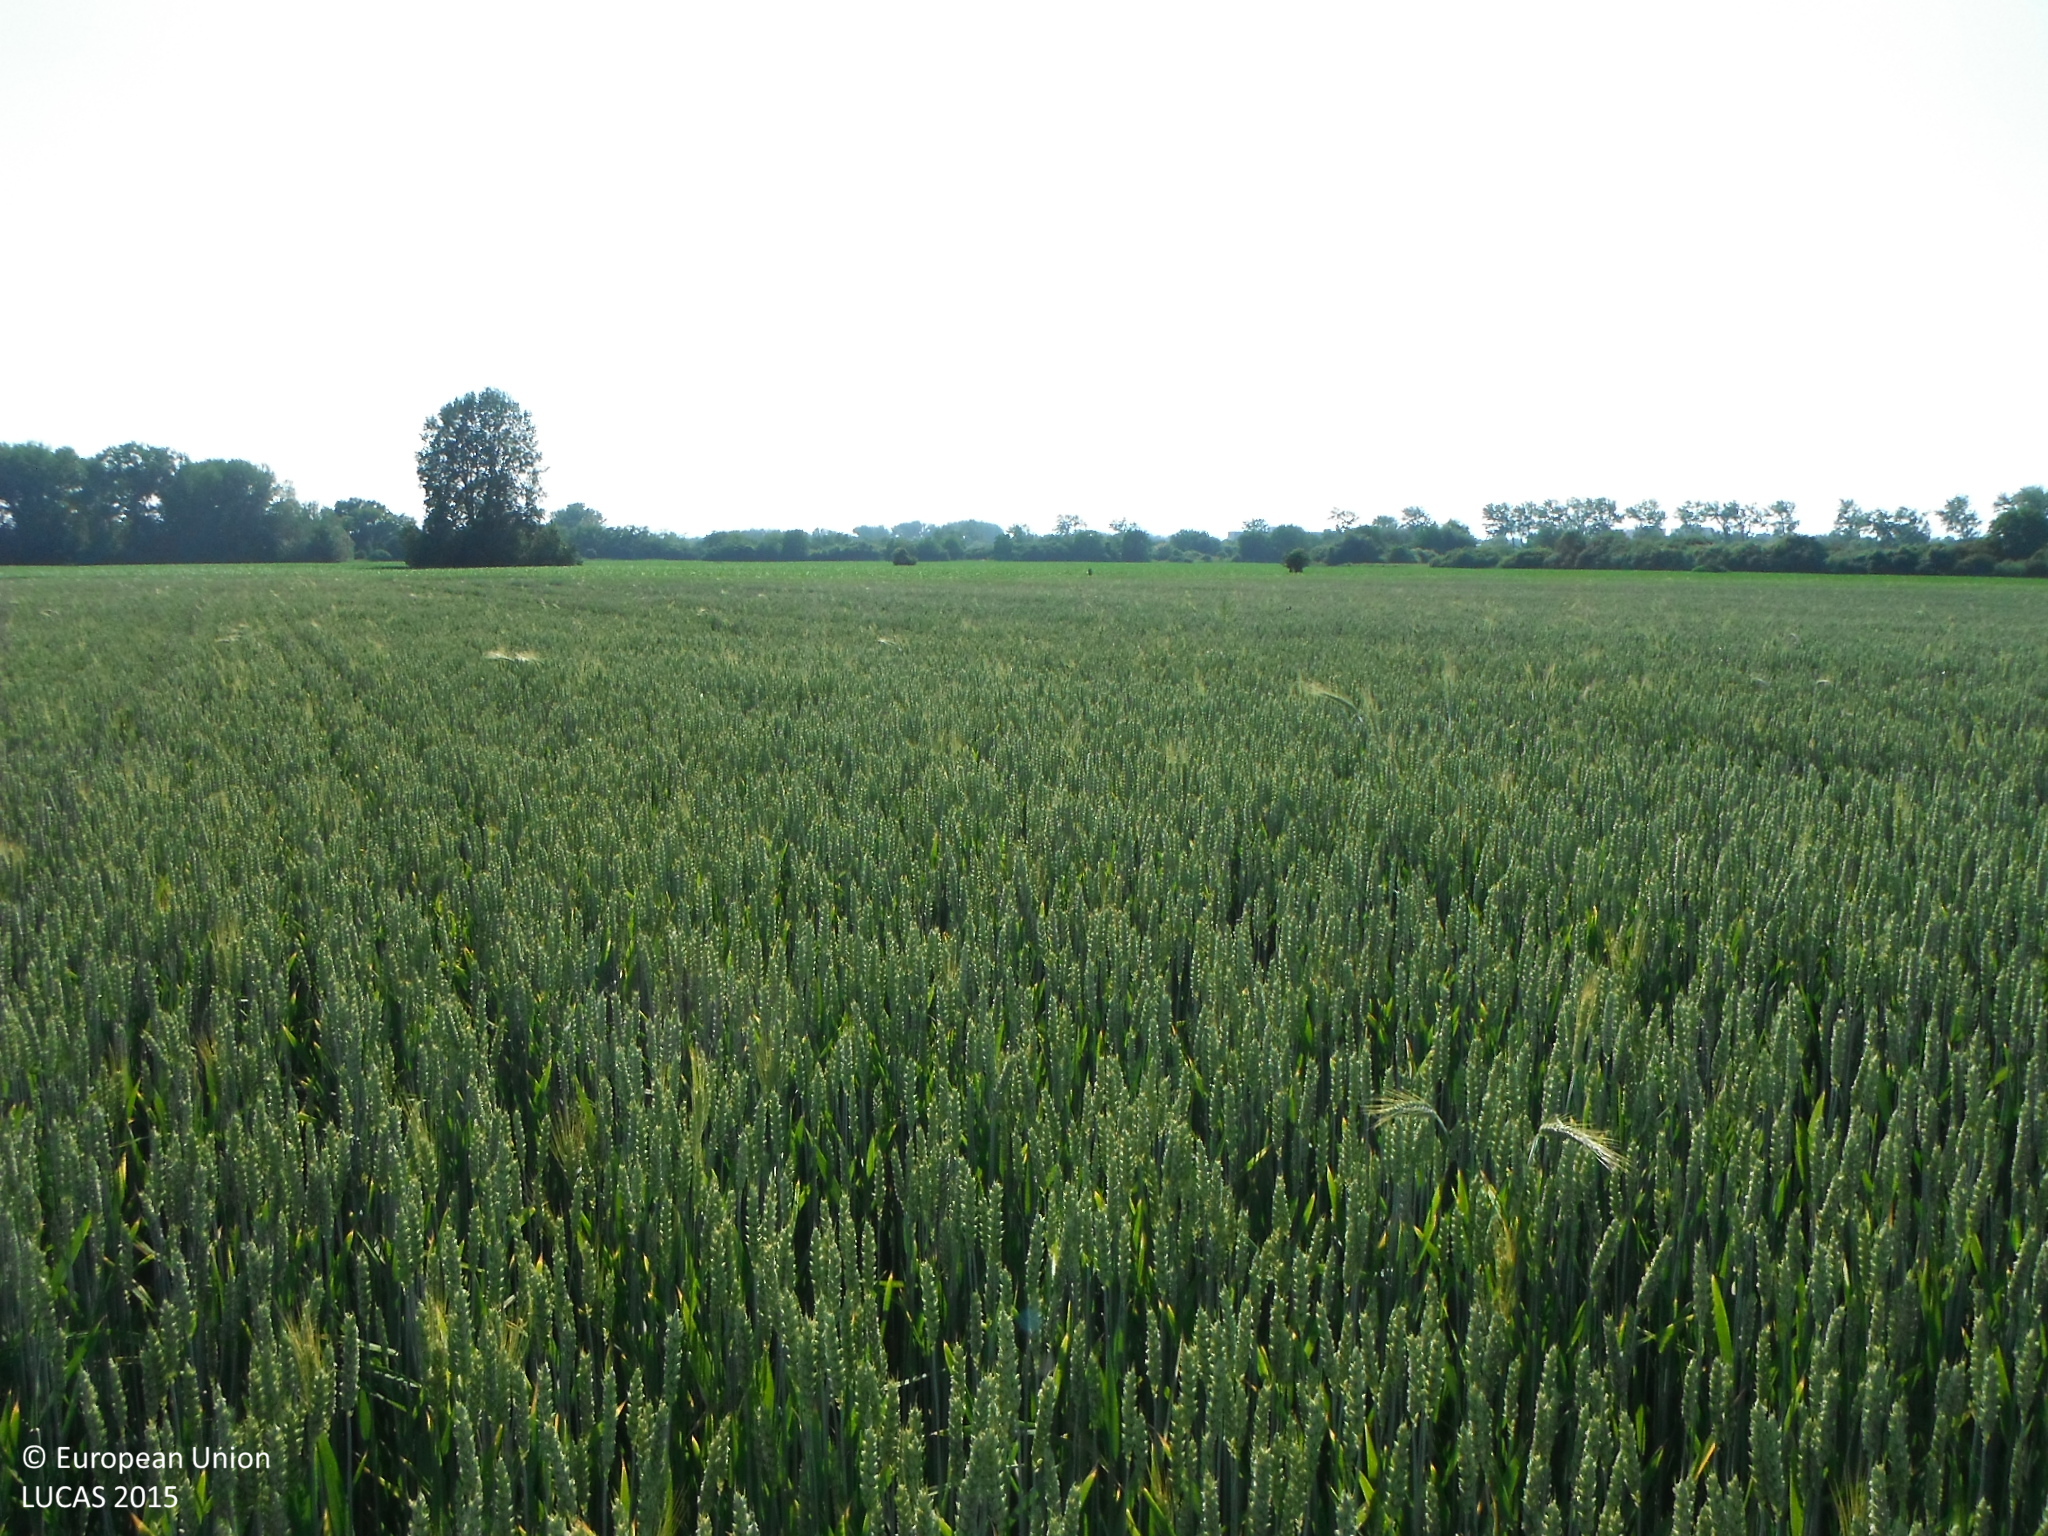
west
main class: Cropland
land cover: Common wheat
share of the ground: > 75 %
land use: Agriculture (excluding fallow land and kitchen gardens)
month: June
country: SK
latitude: 48.7524
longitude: 21.9554
